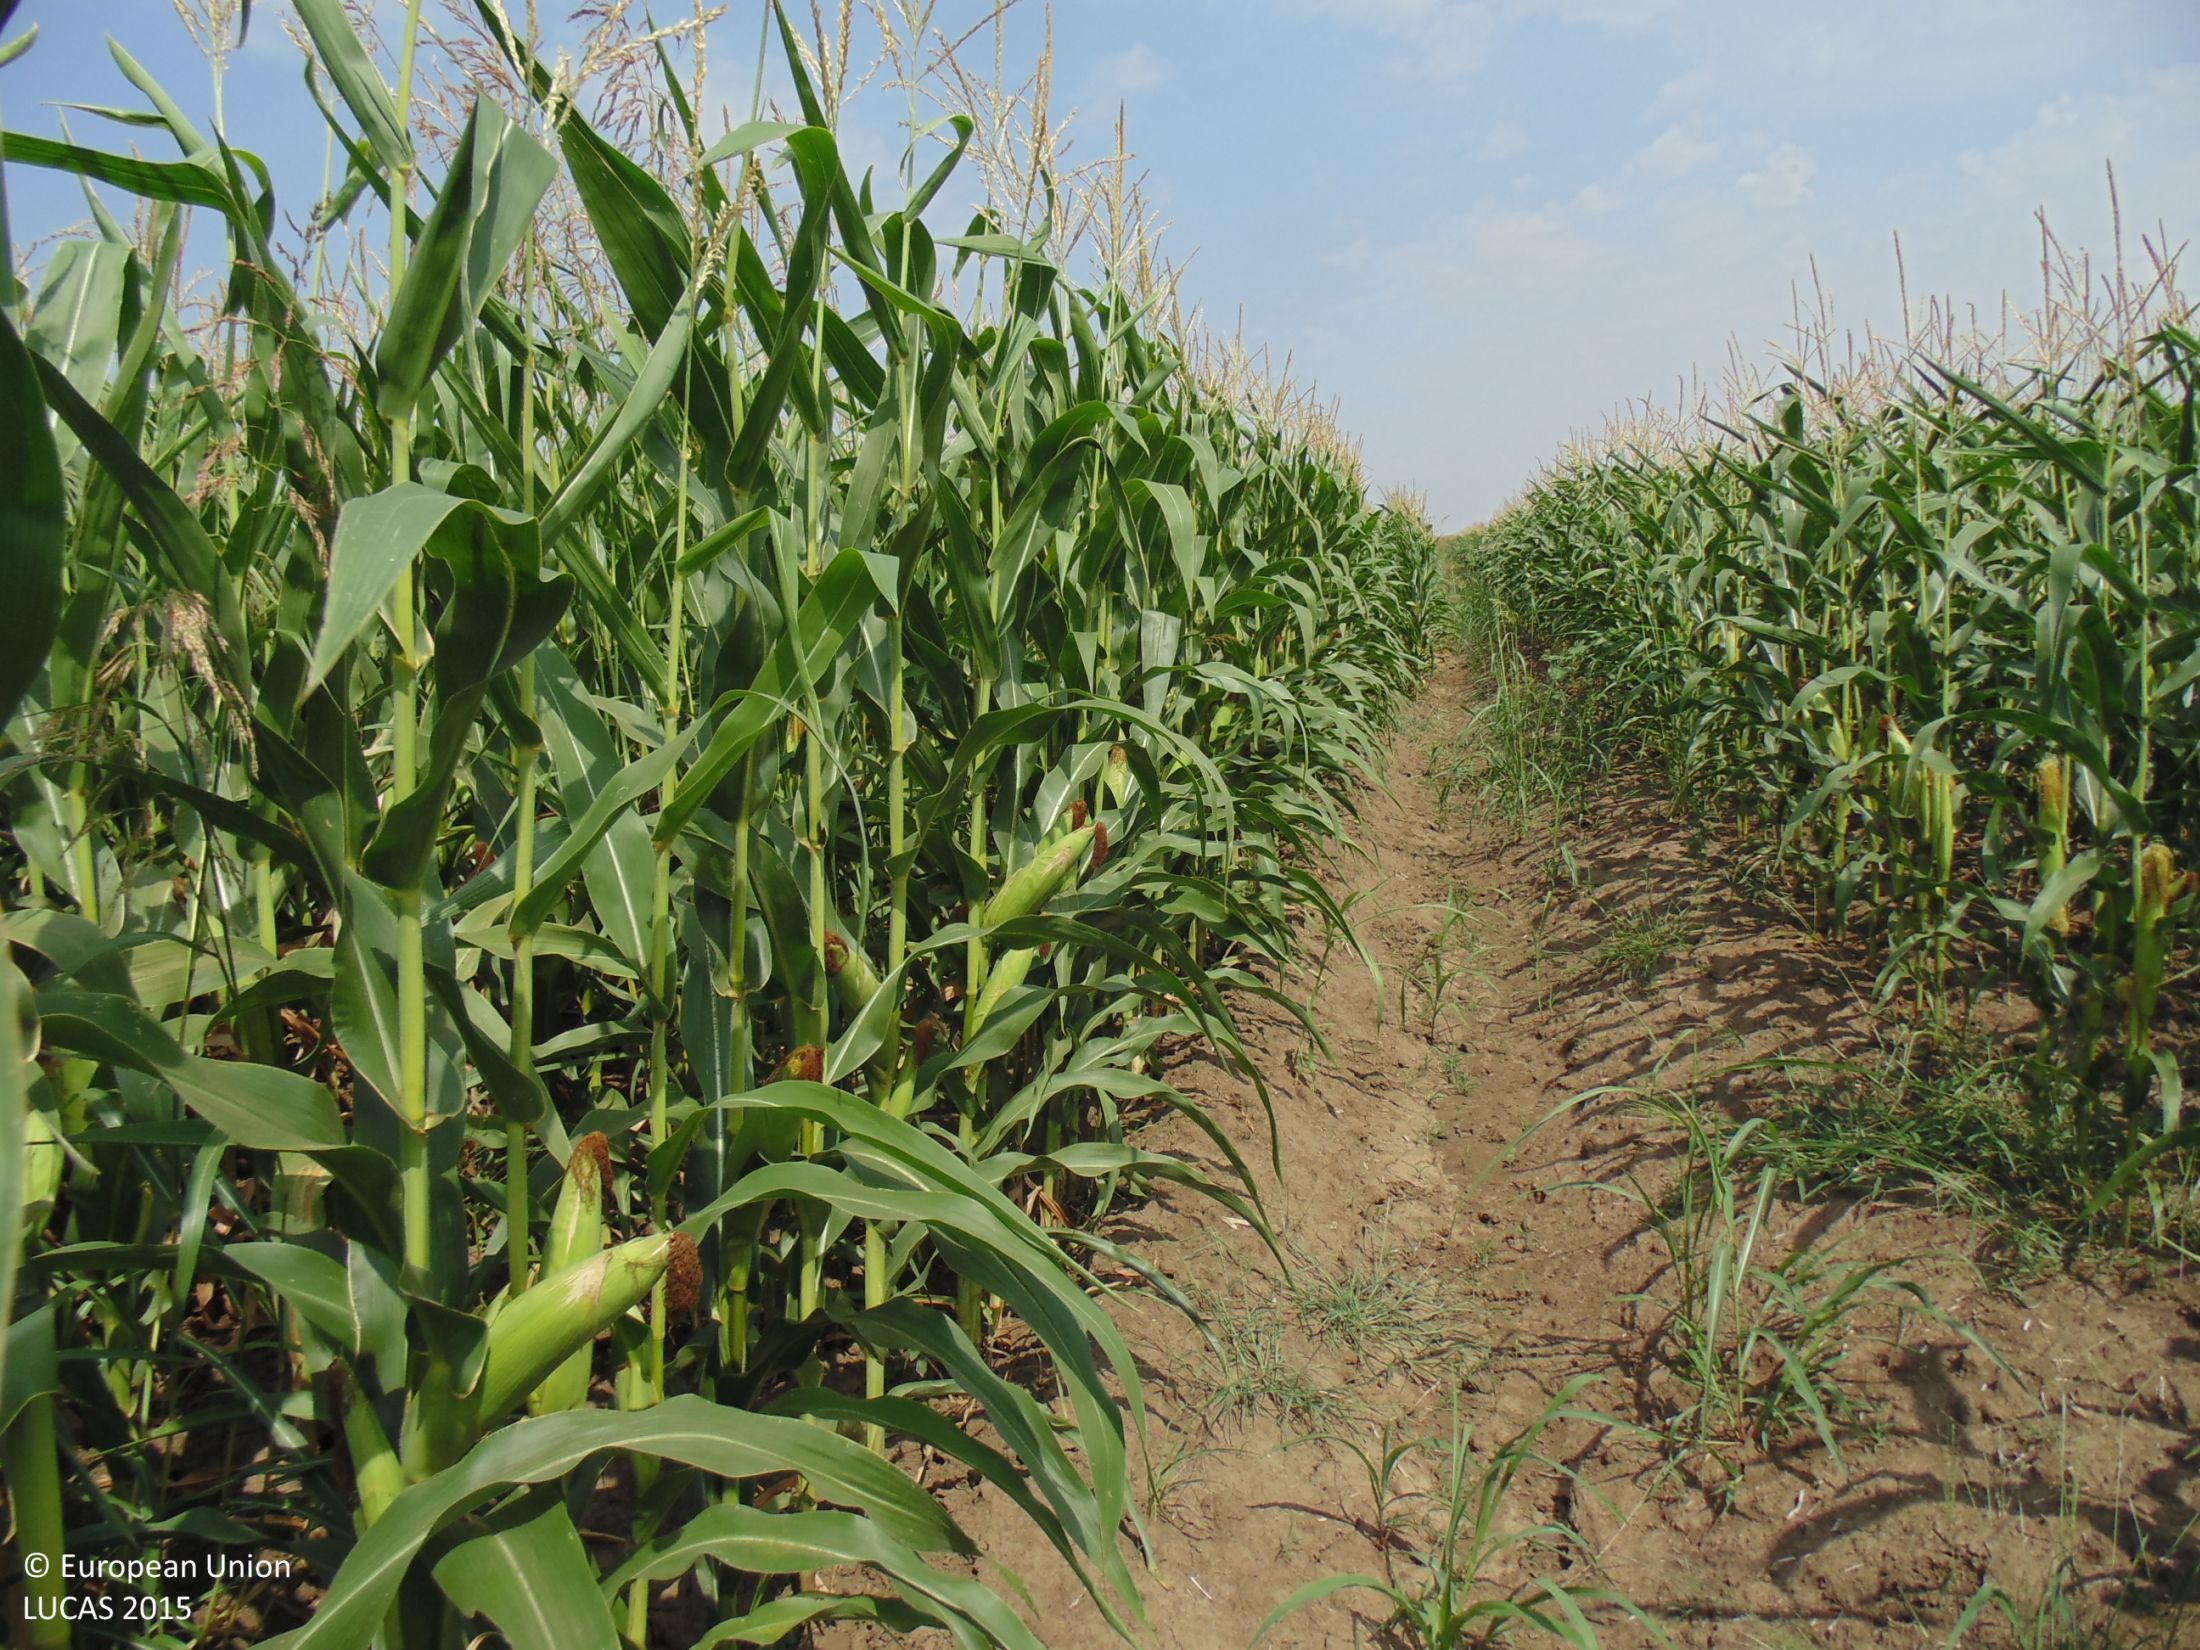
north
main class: Cropland
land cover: Maize
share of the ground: > 75 %
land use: Agriculture (excluding fallow land and kitchen gardens)
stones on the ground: < 10 %
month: August
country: BG
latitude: 43.7922
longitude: 28.1105
